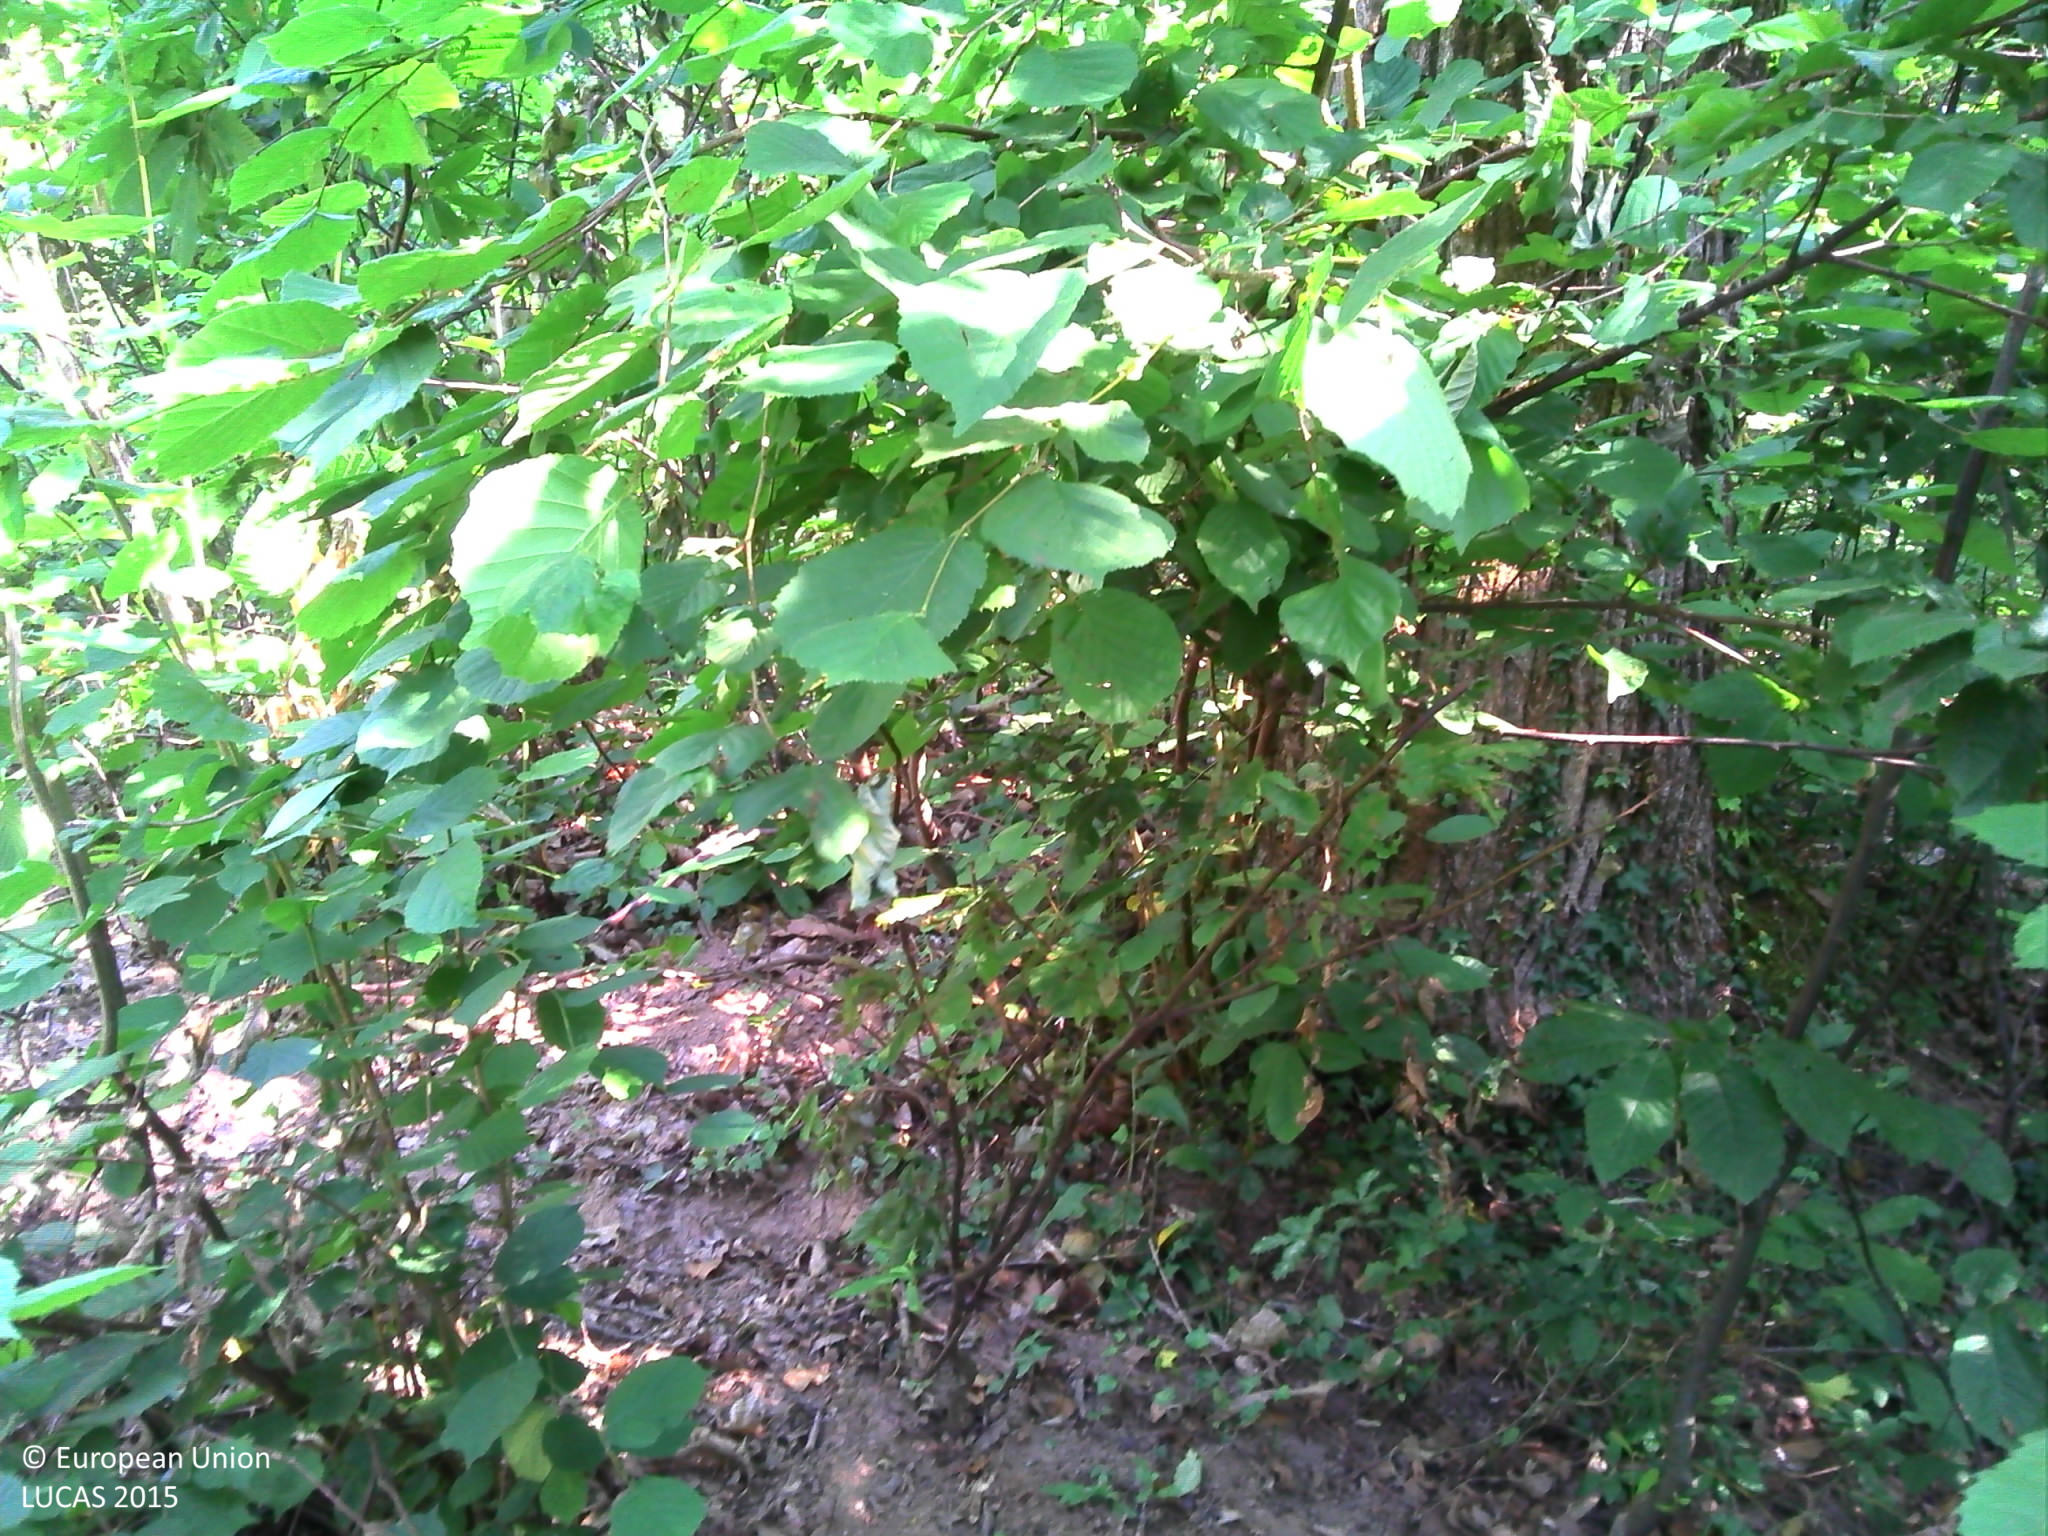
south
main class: Woodland
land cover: Broadleaved woodland
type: thermophilous deciduous forest
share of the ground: > 75 %
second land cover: Spontaneously vegetated surfaces
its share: > 75 %
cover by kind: broadleaved forest trees 80 %, herbaceous plants 15 %, shrubs 5 %
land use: Forestry
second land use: Agriculture (excluding fallow land and kitchen gardens)
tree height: > 5 m
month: June
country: FR
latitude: 44.5838
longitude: 0.8881
